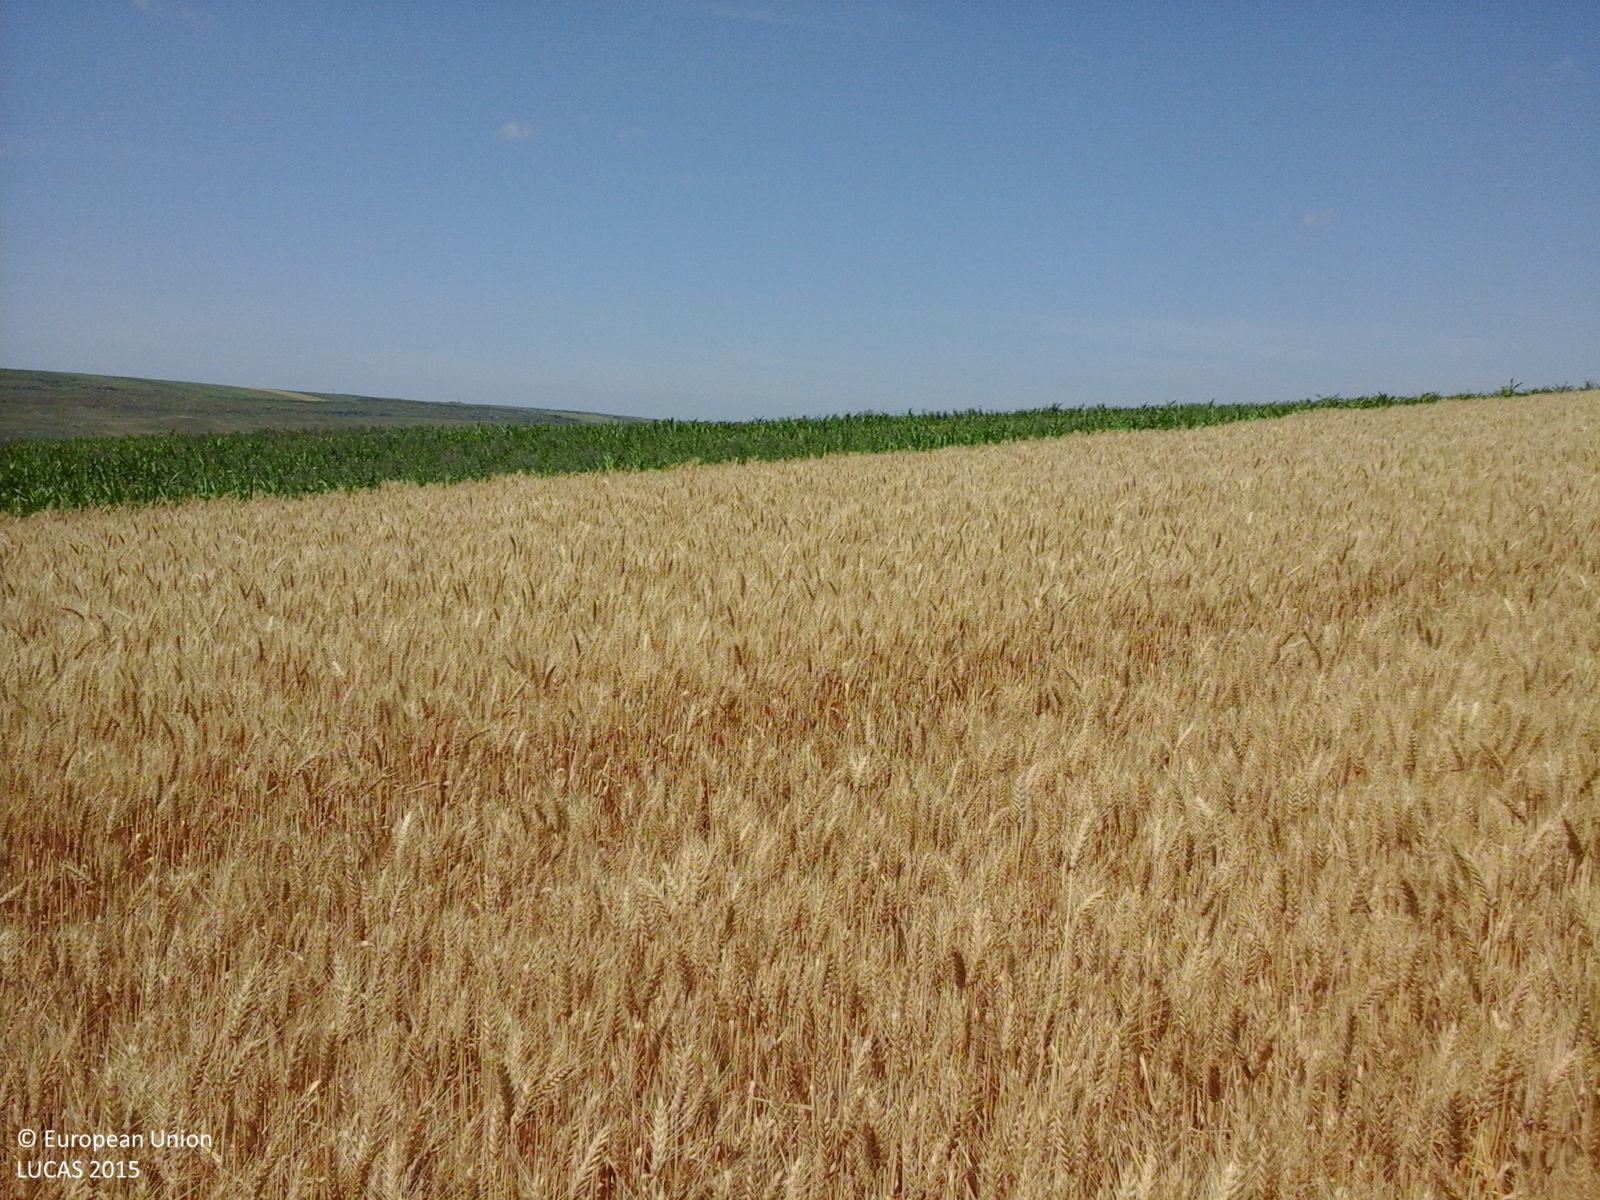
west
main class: Cropland
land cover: Common wheat
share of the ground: > 75 %
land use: Agriculture (excluding fallow land and kitchen gardens)
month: June
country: RO
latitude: 47.2891
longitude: 27.1499
